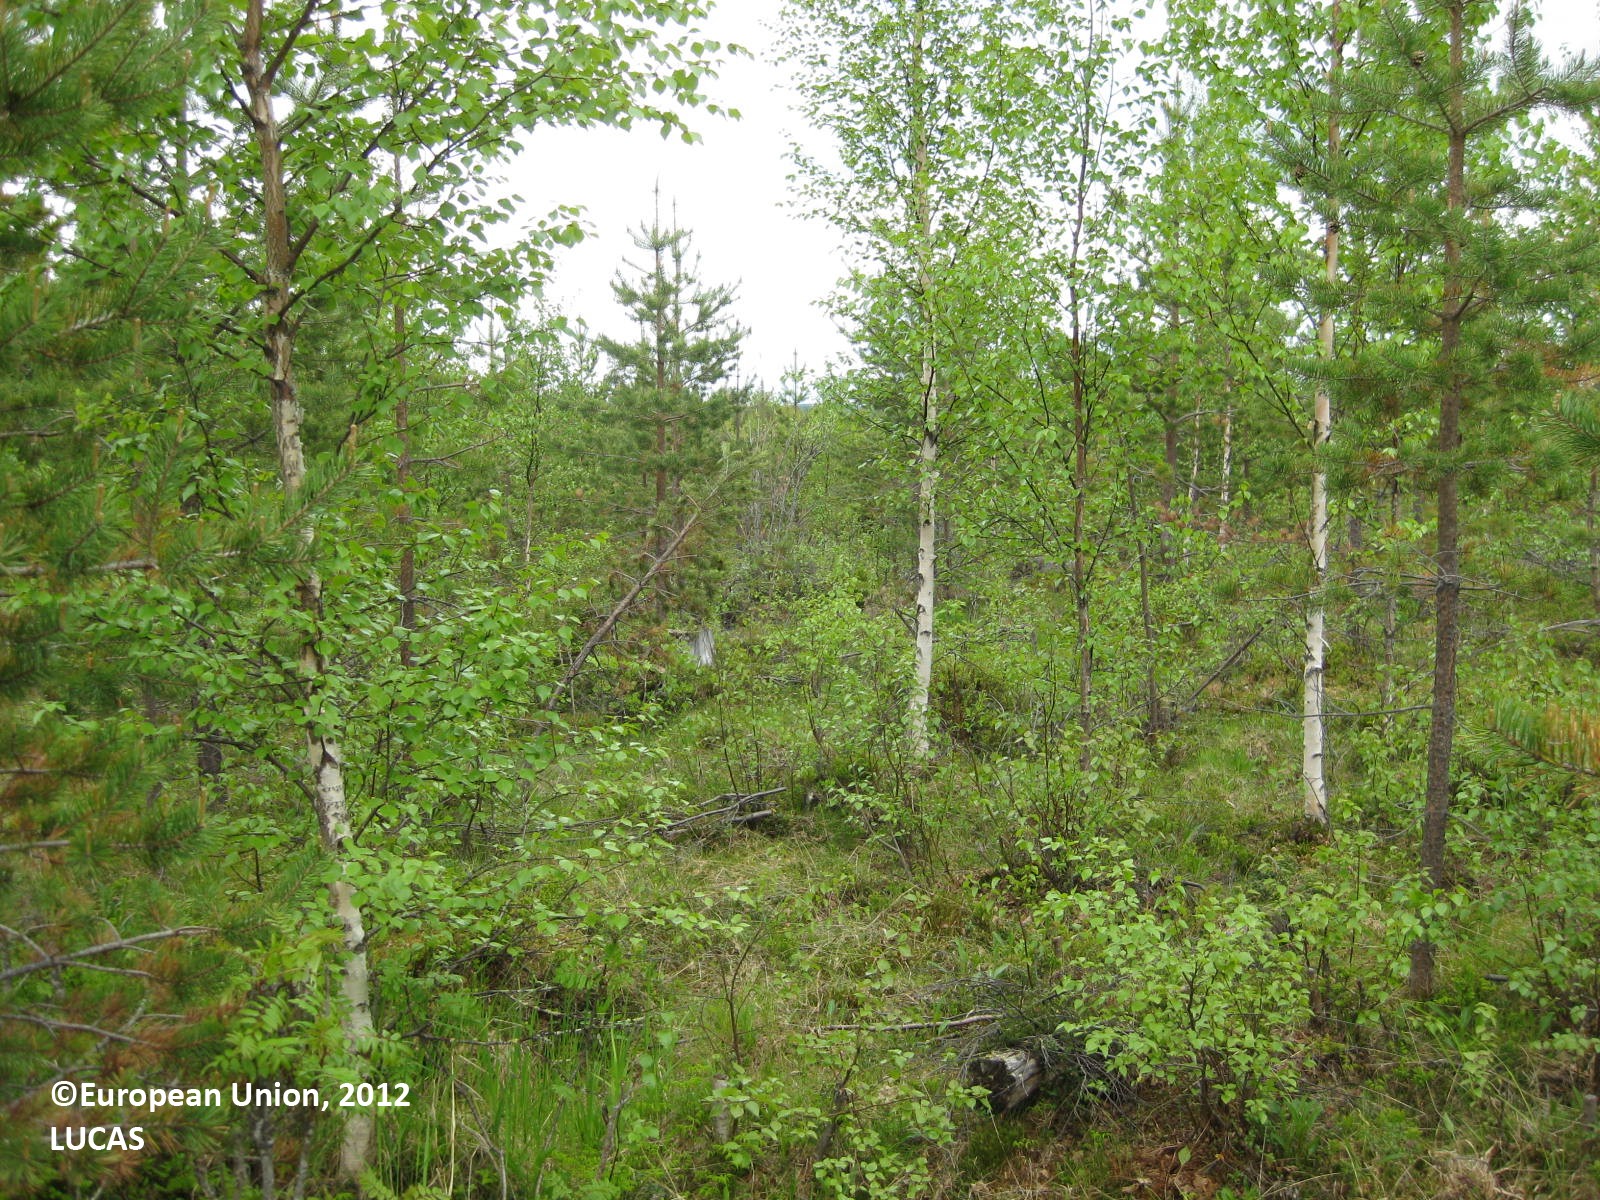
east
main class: Woodland
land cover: Pine dominated mixed woodland
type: boreal forest
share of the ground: 50 - 75 %
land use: Forestry
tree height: < 5 m
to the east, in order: Pine dominated mixed woodland; Pine dominated coniferous woodland; Spontaneously vegetated surfaces; Broadleaved woodland; Ditches and canals; Broadleaved woodland; Ditches and canals; Broadleaved woodland; Pine dominated mixed woodland; Paved roads, cycling and walking lanes; Pine dominated mixed woodland; Spruce dominated mixed woodland
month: June
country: FI
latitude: 65.2240
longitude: 28.9366
